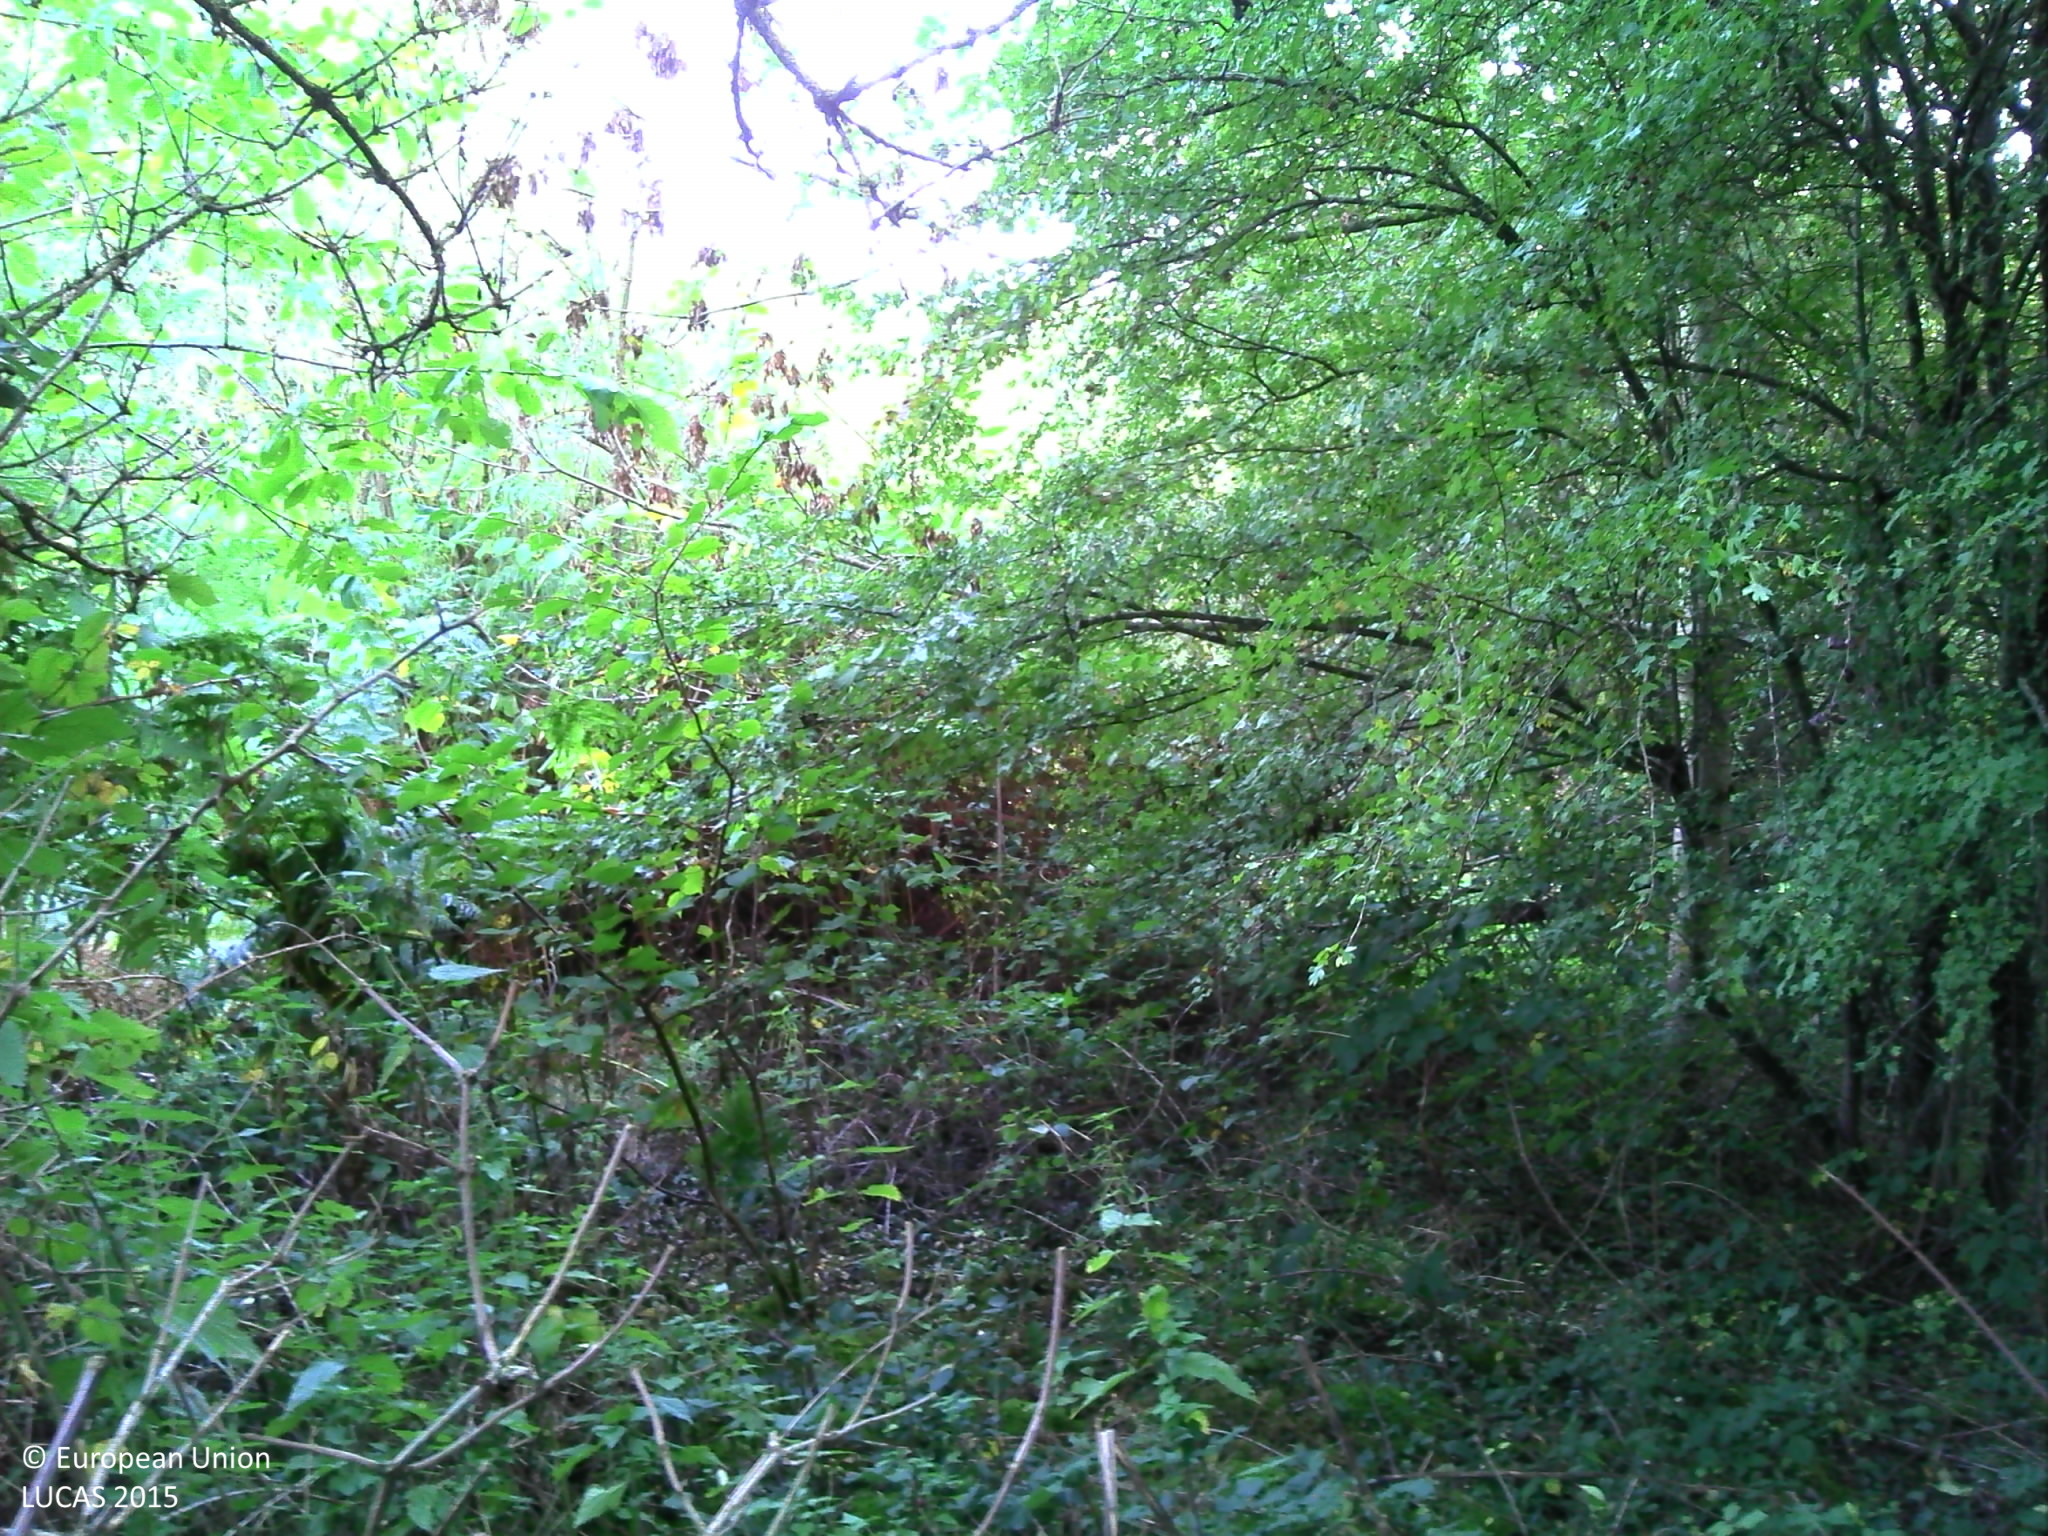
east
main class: Woodland
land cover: Broadleaved woodland
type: mesophytic deciduous forest
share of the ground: > 75 %
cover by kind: broadleaved forest trees 75 %, herbaceous plants 25 %
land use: Forestry
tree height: > 5 m
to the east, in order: Broadleaved woodland; Spontaneously vegetated surfaces; Broadleaved woodland; Grassland without tree/shrub cover; Fences; Grassland without tree/shrub cover; Fences; Electric lines; Grassland without tree/shrub cover
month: September
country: FR
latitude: 46.1633
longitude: 2.8099
